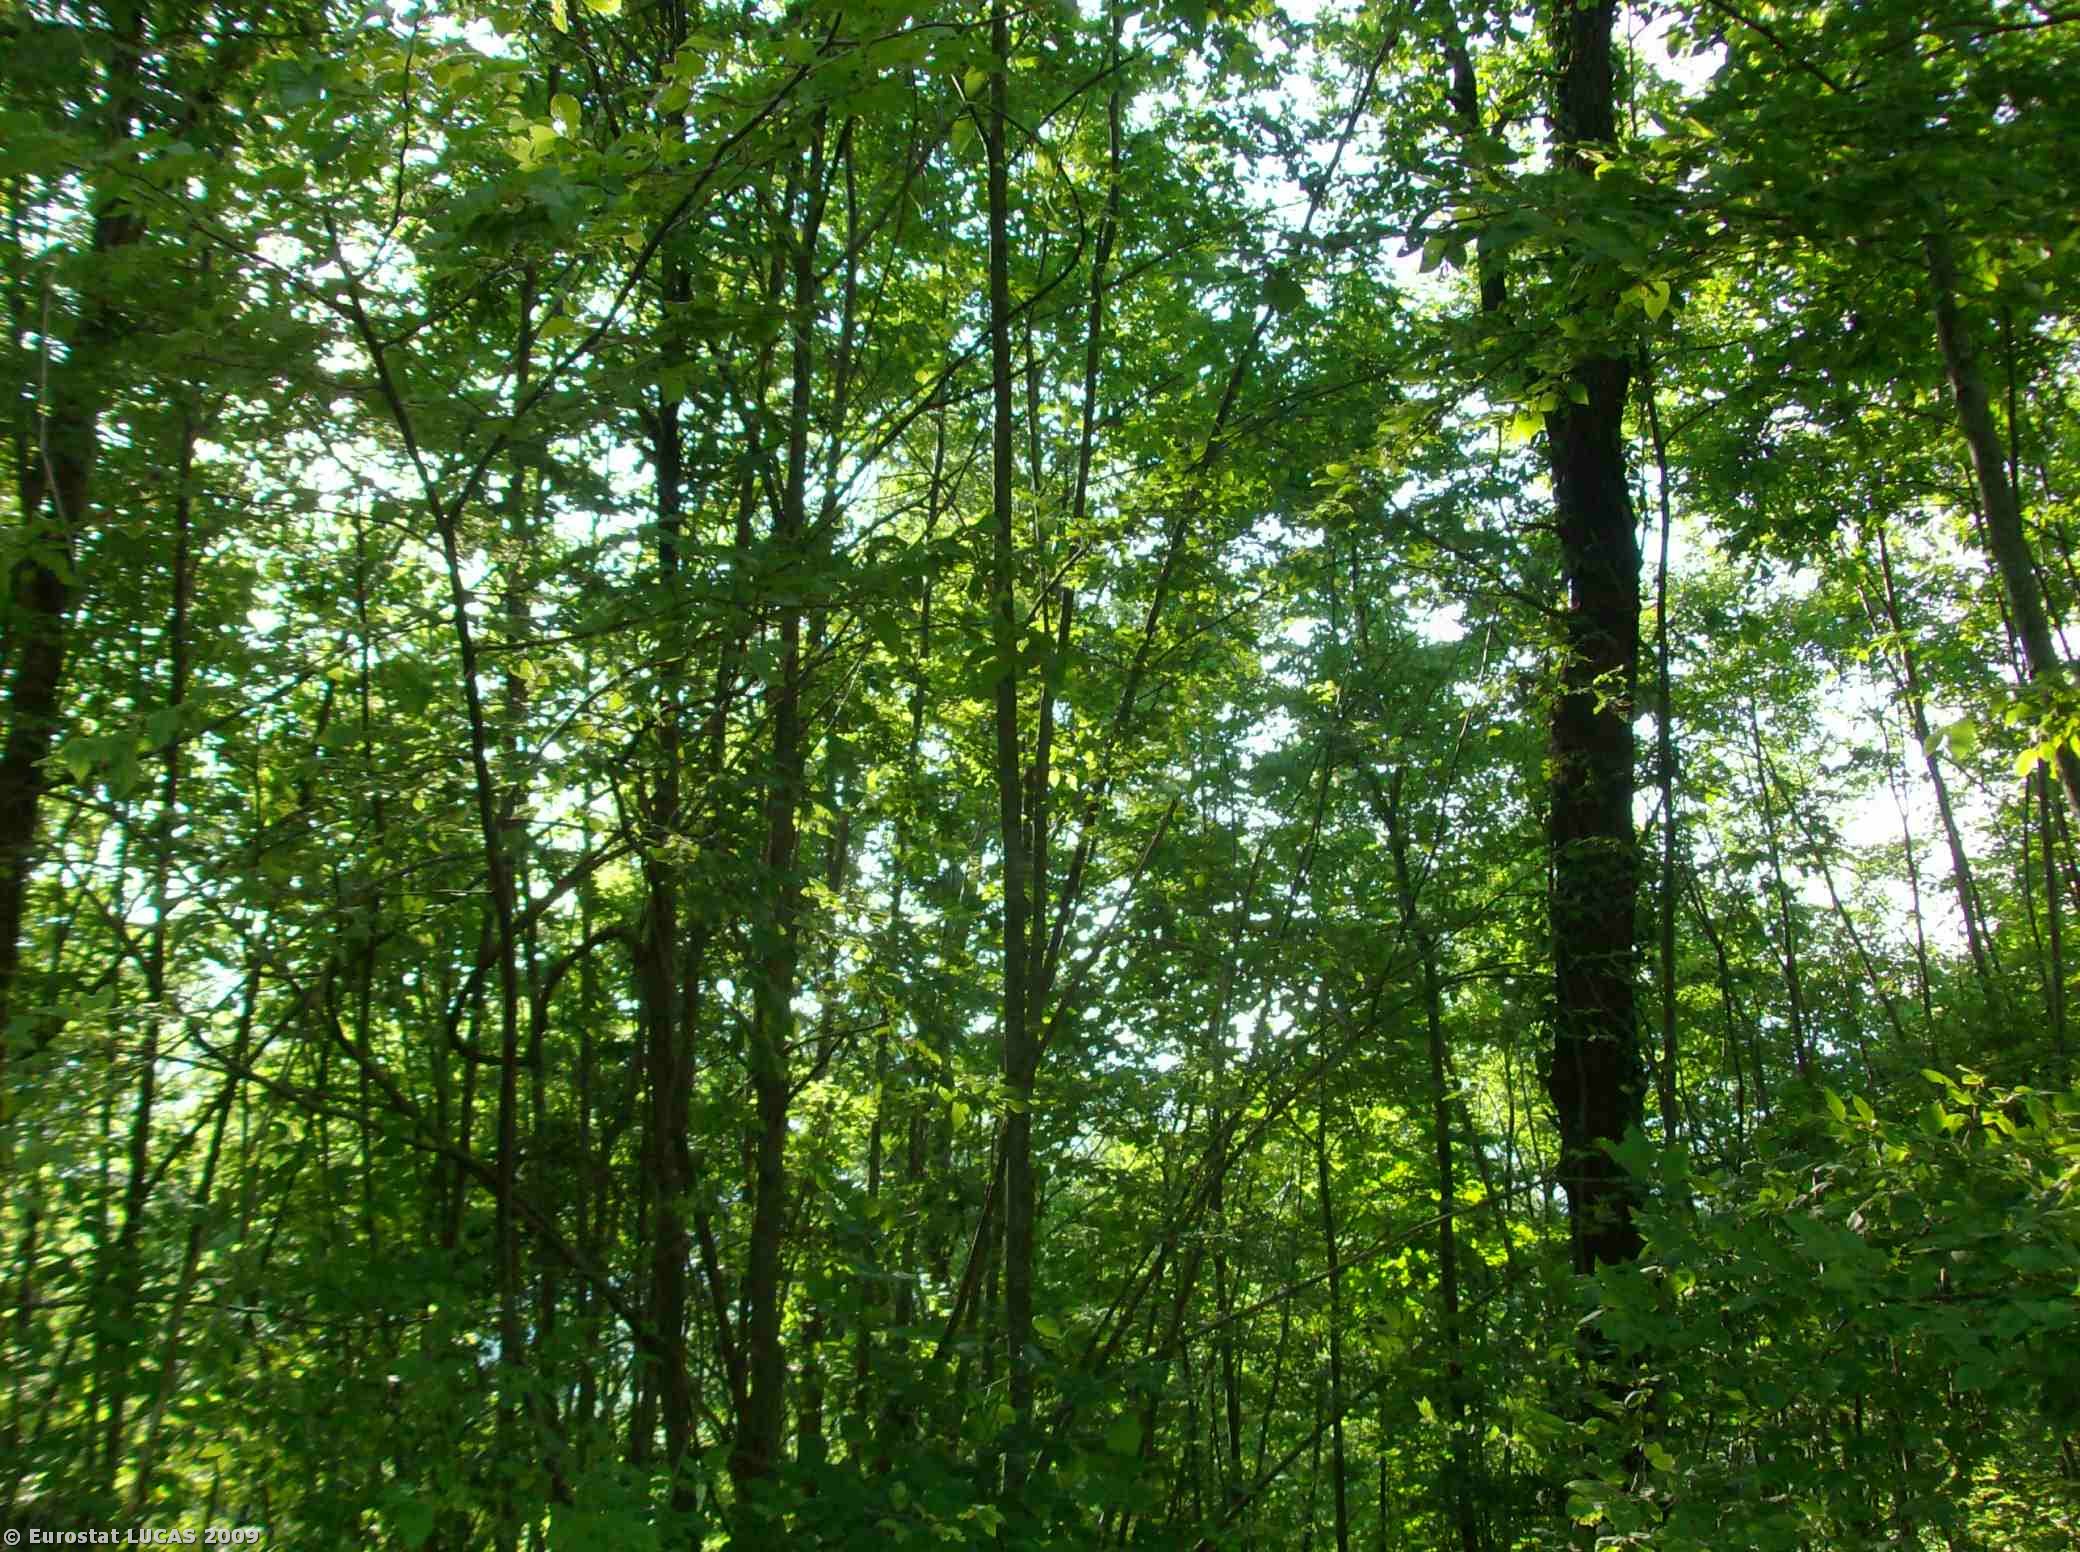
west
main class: Woodland
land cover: Broadleaved woodland
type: thermophilous deciduous forest
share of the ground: > 75 %
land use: Forestry
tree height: > 5 m
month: June
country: IT
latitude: 42.8040
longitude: 11.5967
